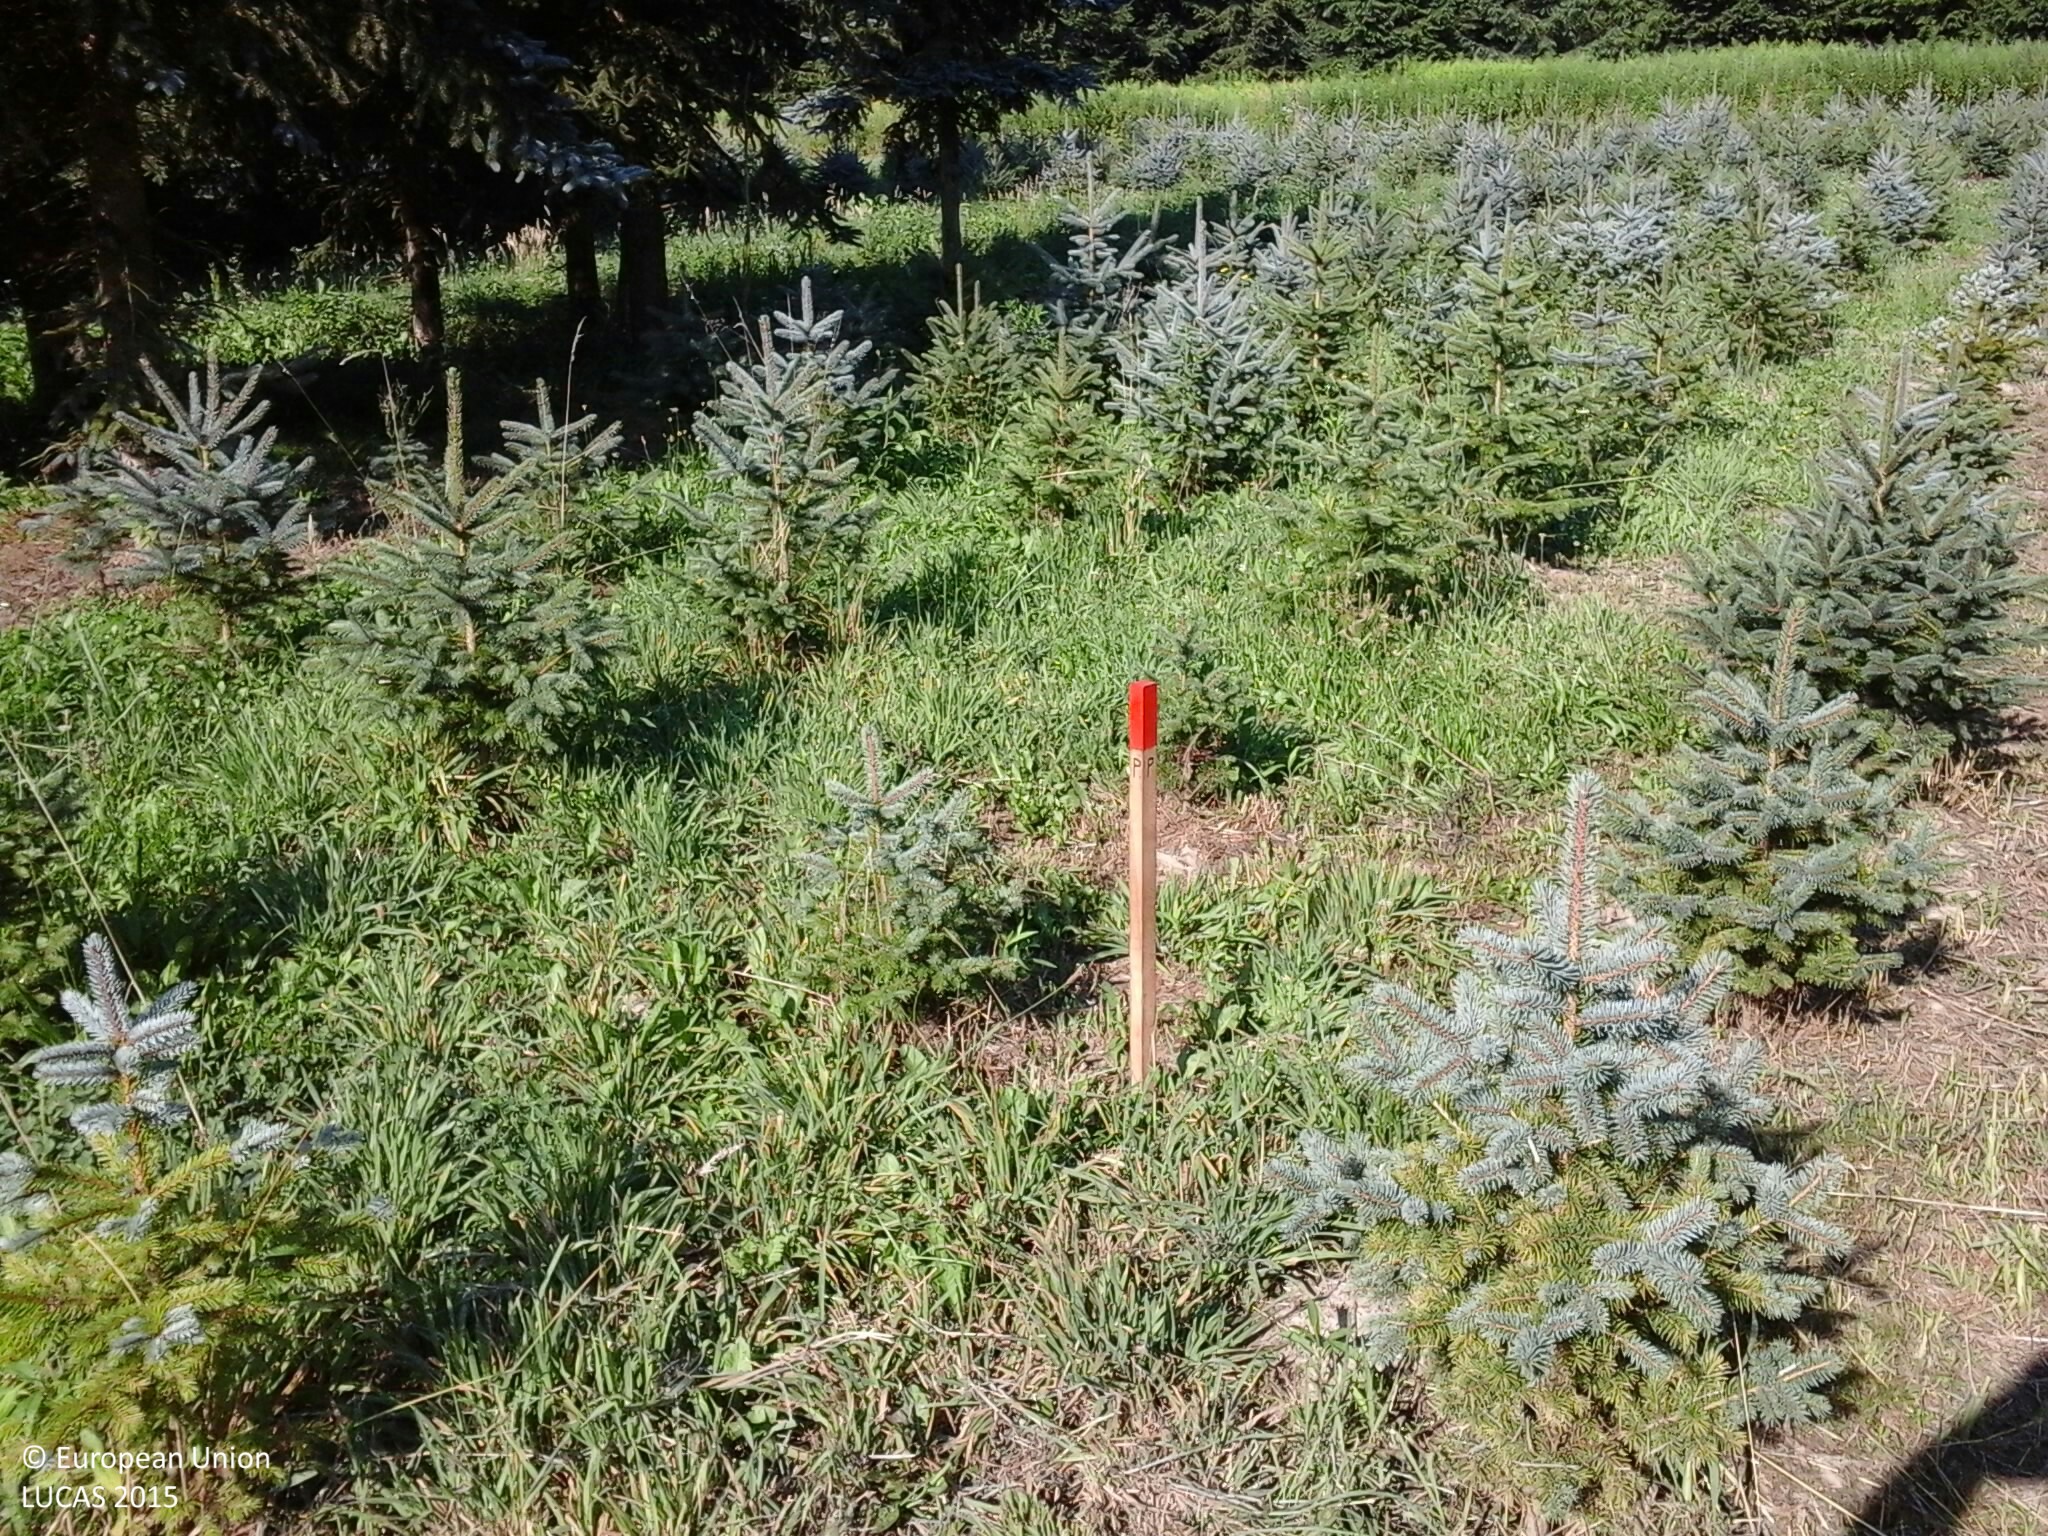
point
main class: Cropland
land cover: Nurseries
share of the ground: 25 - 50 %
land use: Forestry
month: July
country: HU
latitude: 46.9721
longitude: 16.4034
